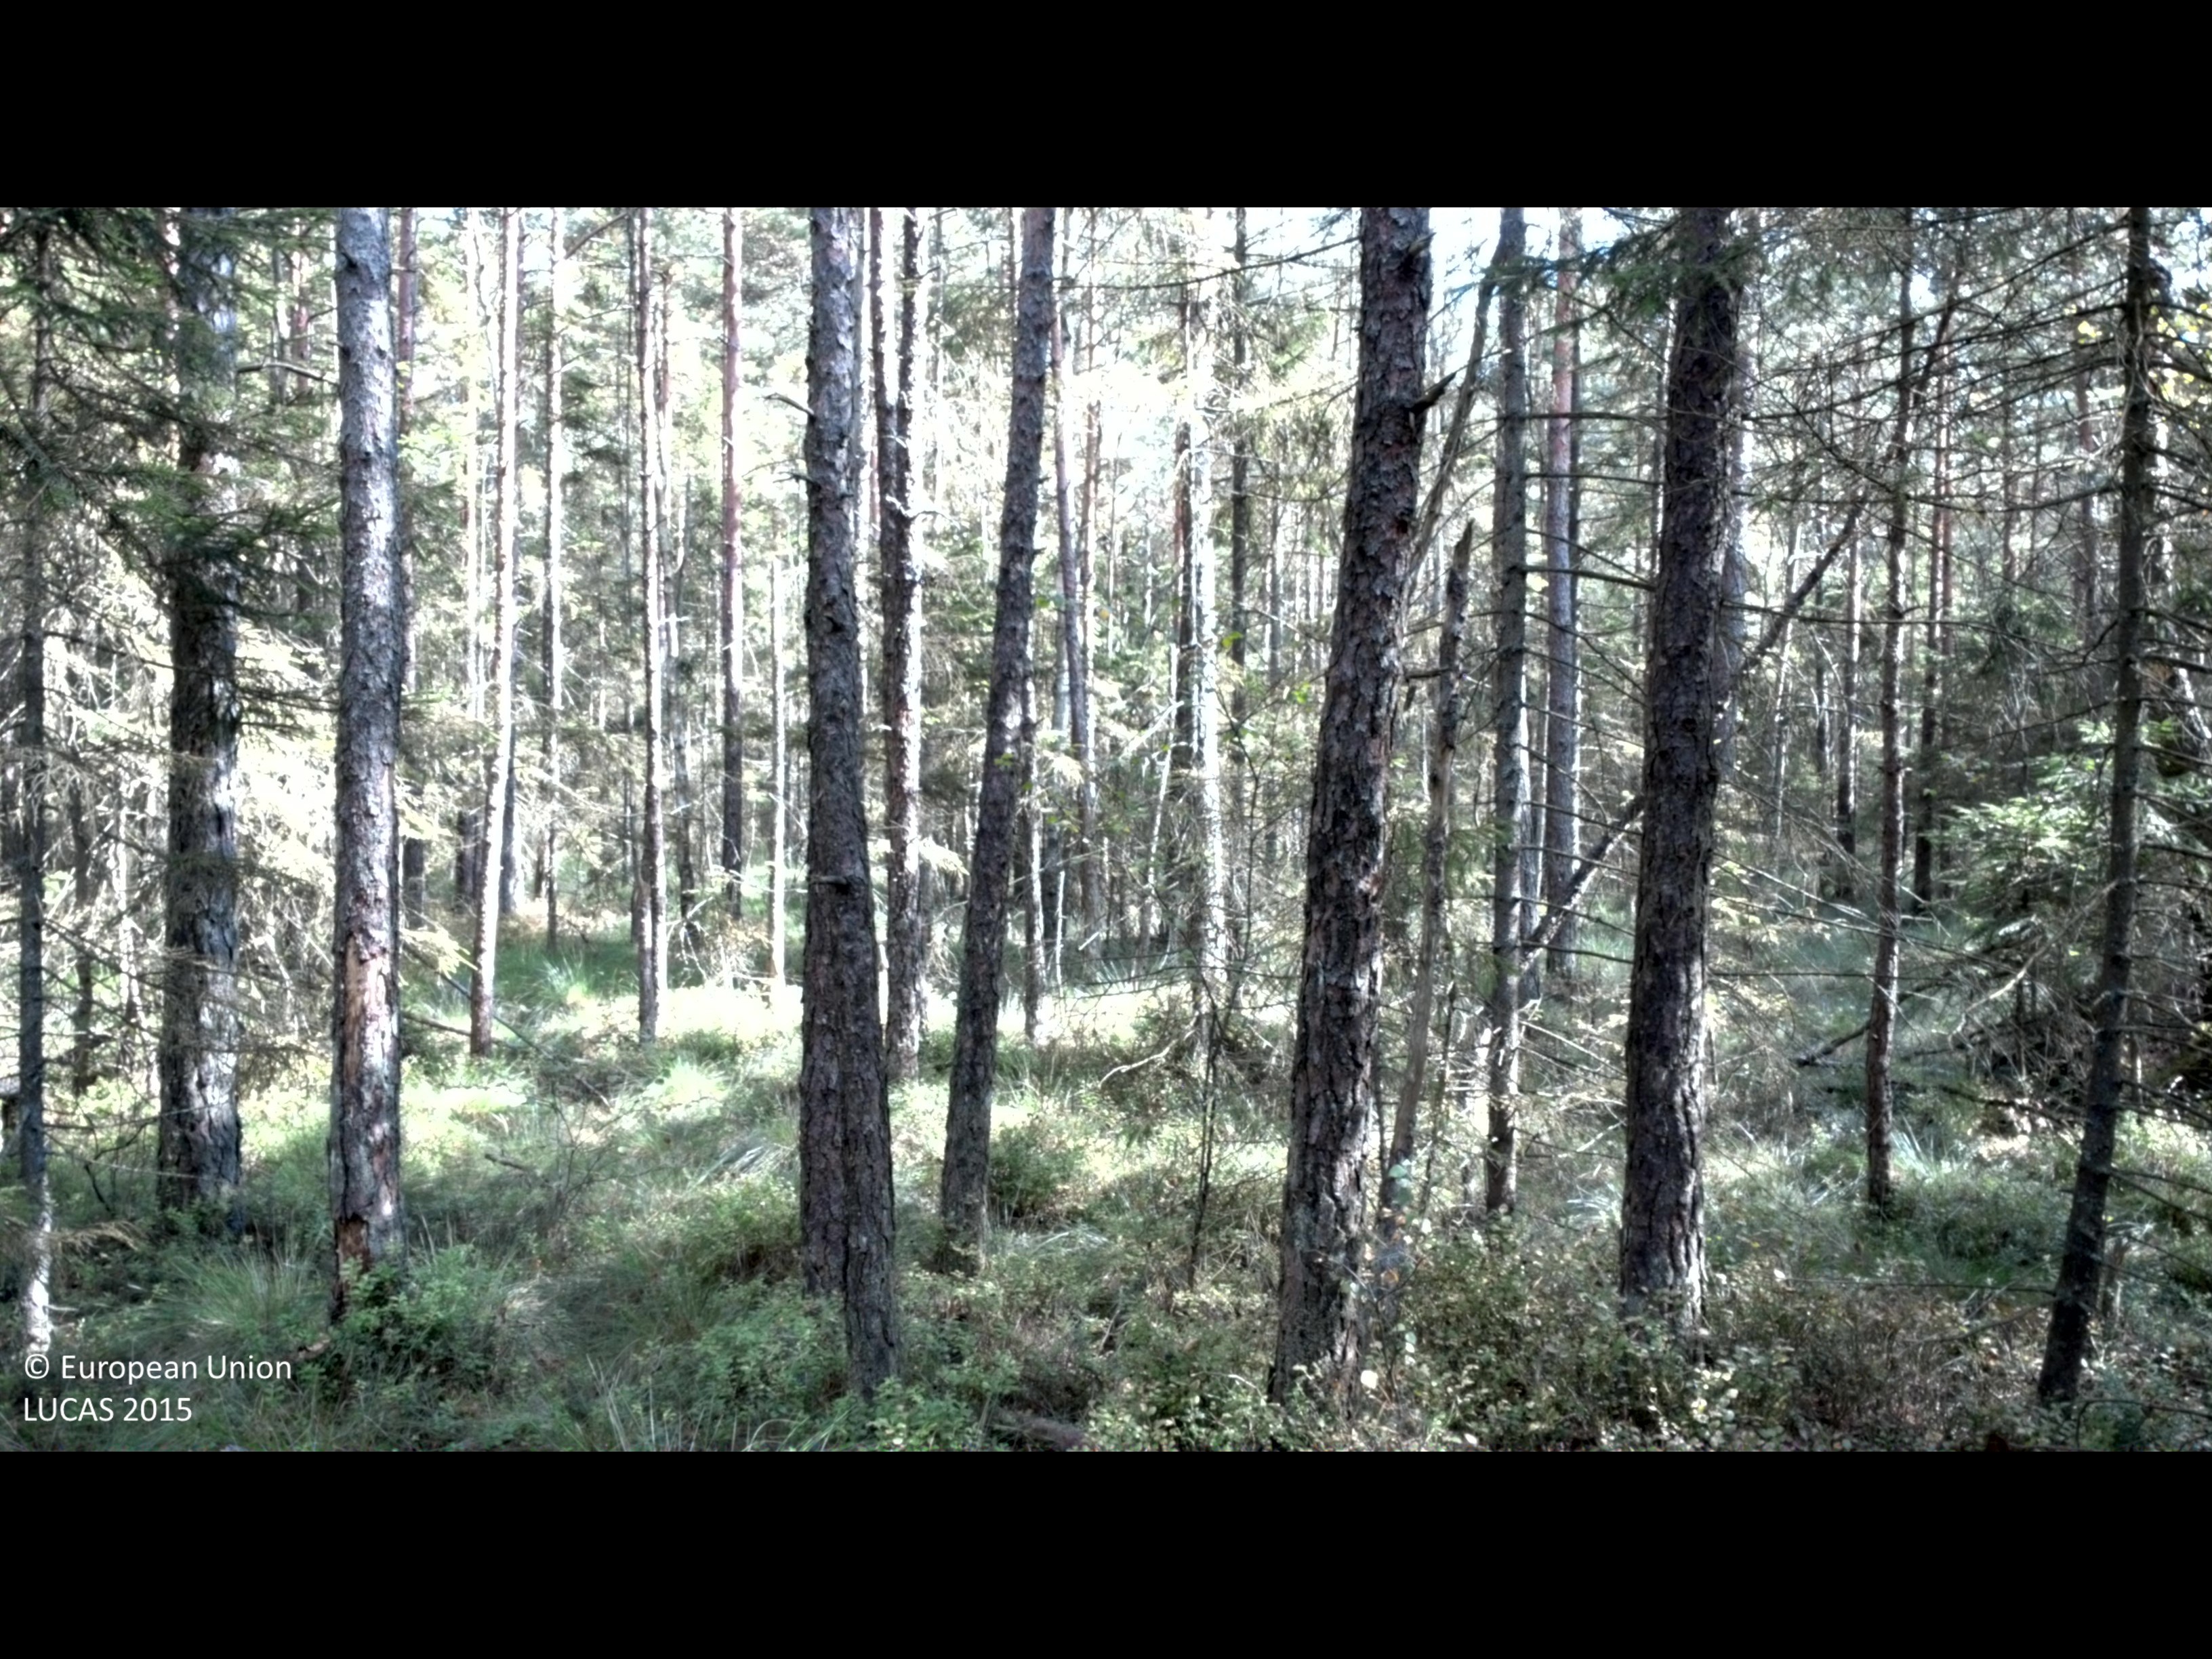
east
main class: Woodland
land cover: Pine dominated coniferous woodland
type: boreal forest
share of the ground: 50 - 75 %
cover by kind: coniferous forest trees 55 %, shrubs 30 %, broadleaved forest trees 15 %
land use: Forestry
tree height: > 5 m
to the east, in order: Pine dominated coniferous woodland; Spruce dominated mixed woodland; Paved roads, cycling and walking lanes; Broadleaved woodland; Spruce dominated coniferous woodland
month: September
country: SE
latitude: 56.7975
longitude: 13.1241
